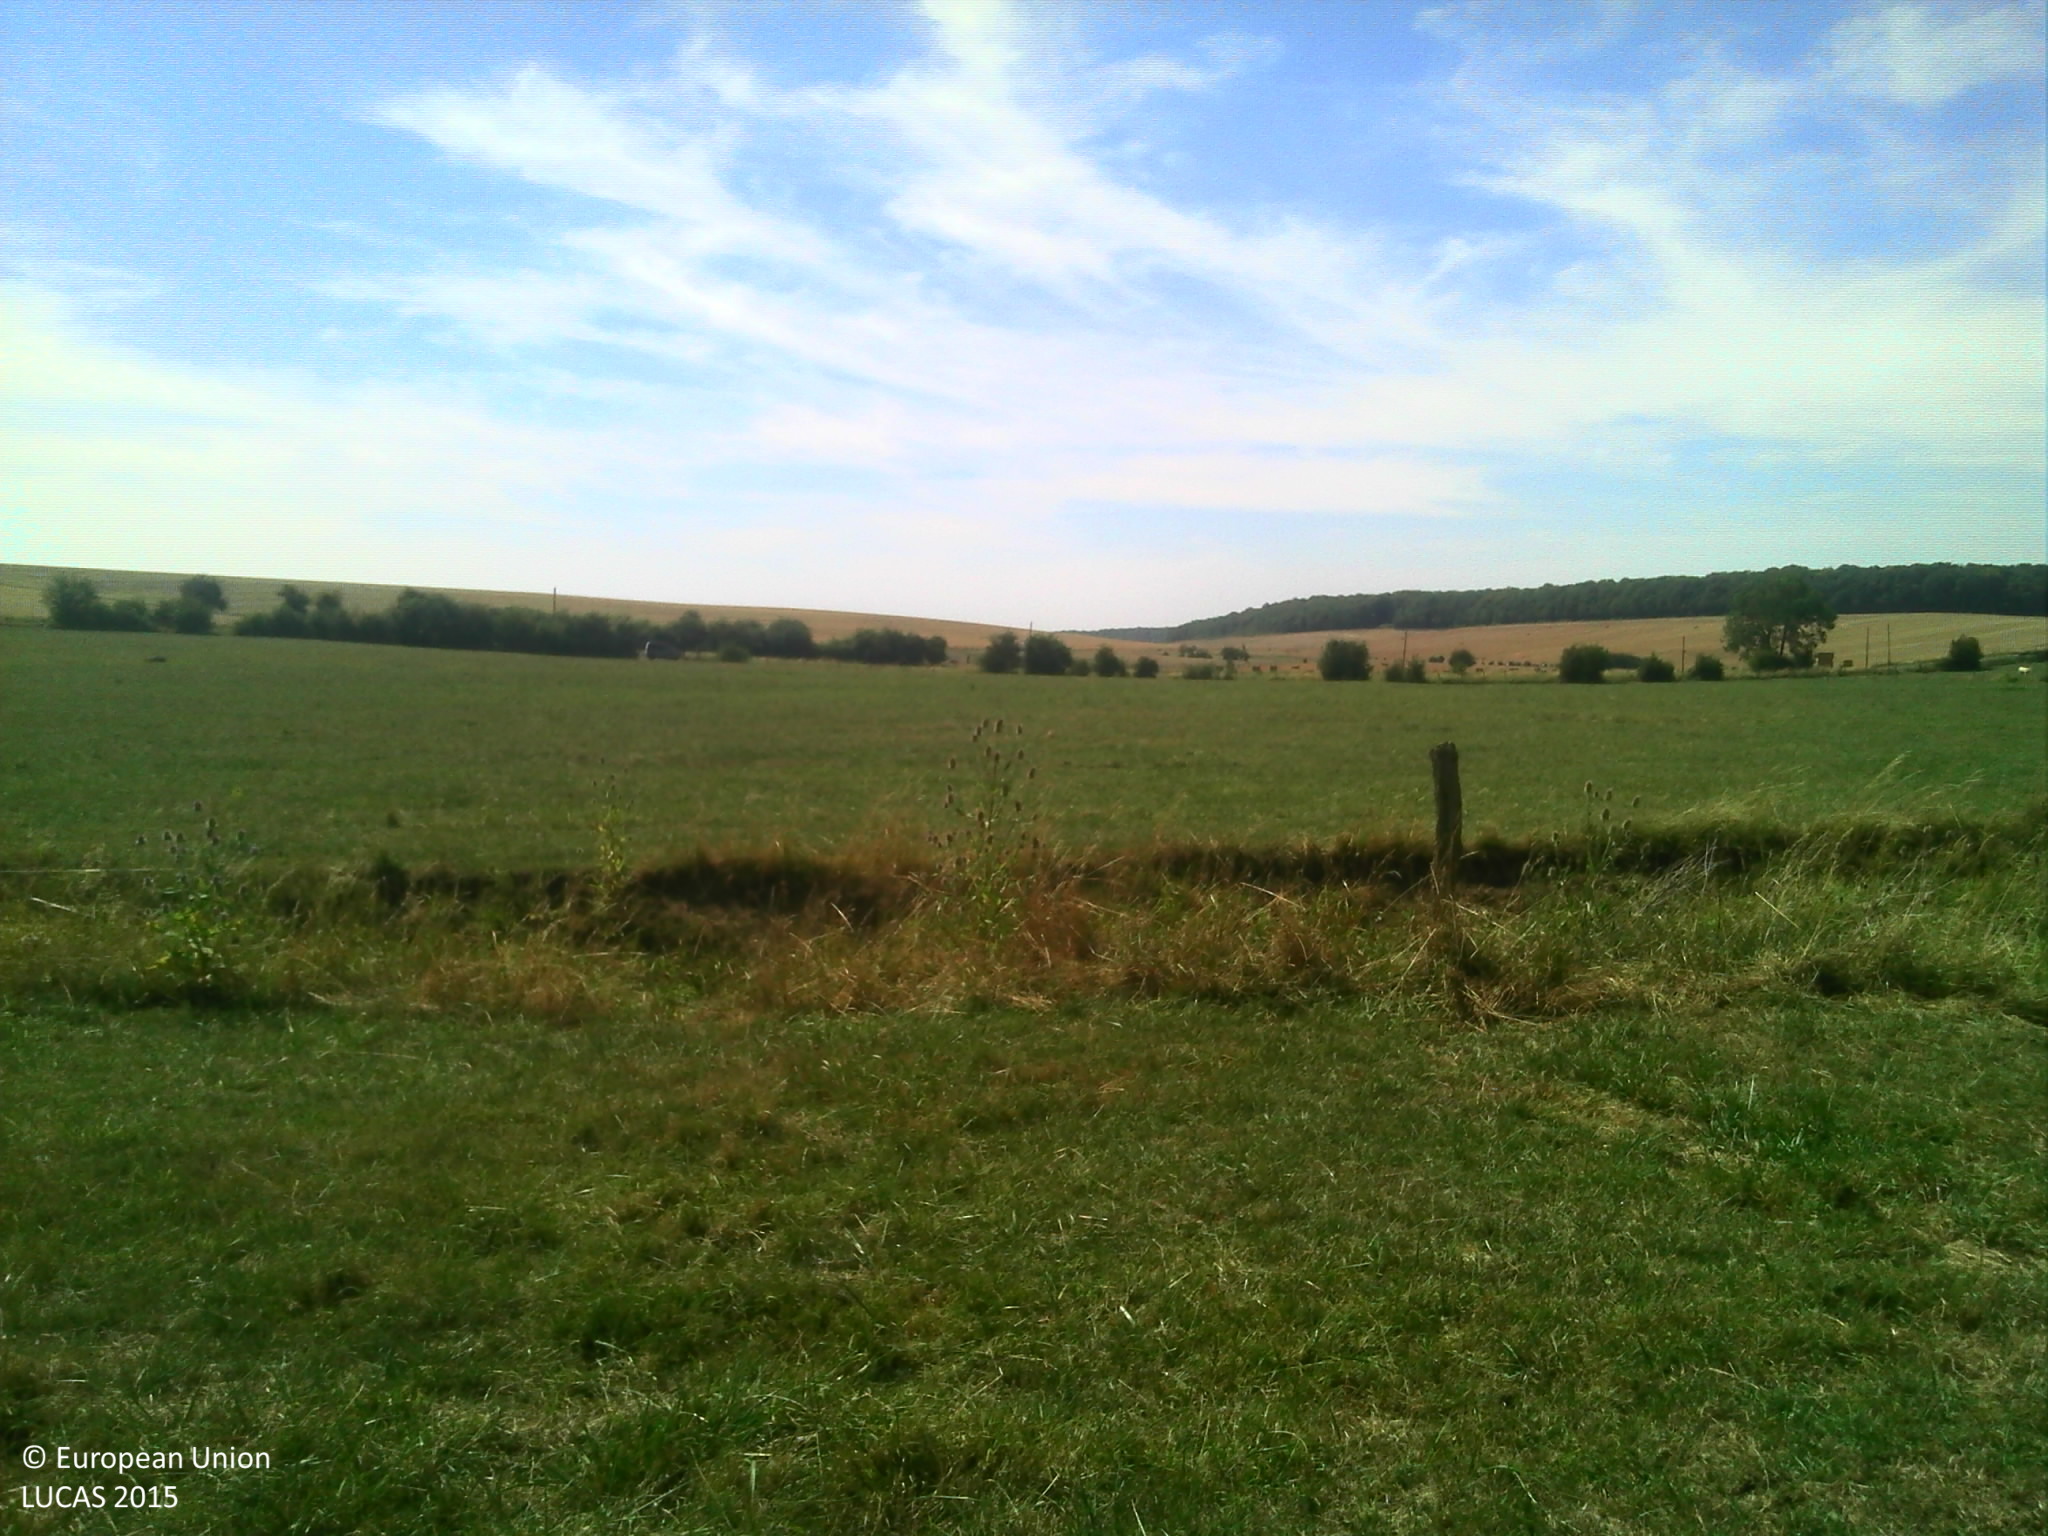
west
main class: Grassland
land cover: Grassland without tree/shrub cover
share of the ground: > 75 %
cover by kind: herbaceous plants 100 %
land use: Agriculture (excluding fallow land and kitchen gardens)
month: August
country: FR
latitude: 49.2881
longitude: 5.1447
